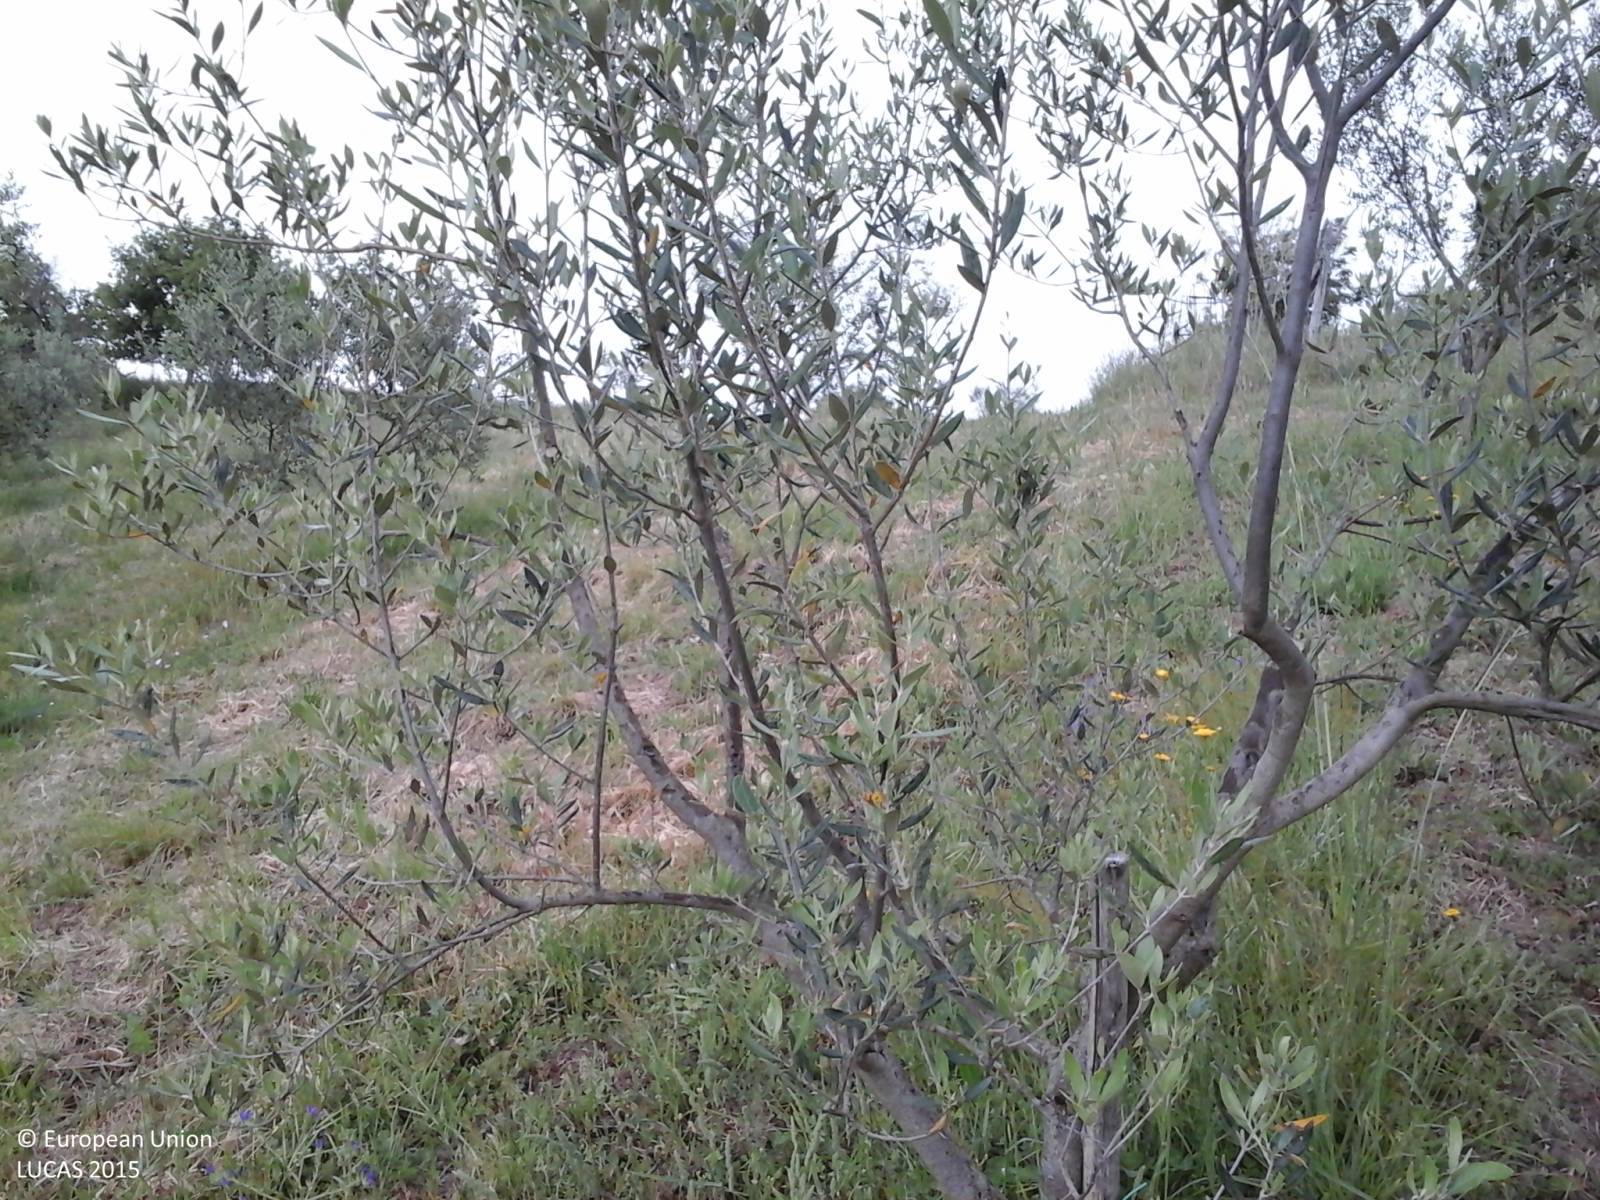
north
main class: Cropland
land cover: Olive groves
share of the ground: 25 - 50 %
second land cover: Grassland without tree/shrub cover
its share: > 75 %
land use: Agriculture (excluding fallow land and kitchen gardens)
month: May
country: IT
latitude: 42.5610
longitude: 12.0517
